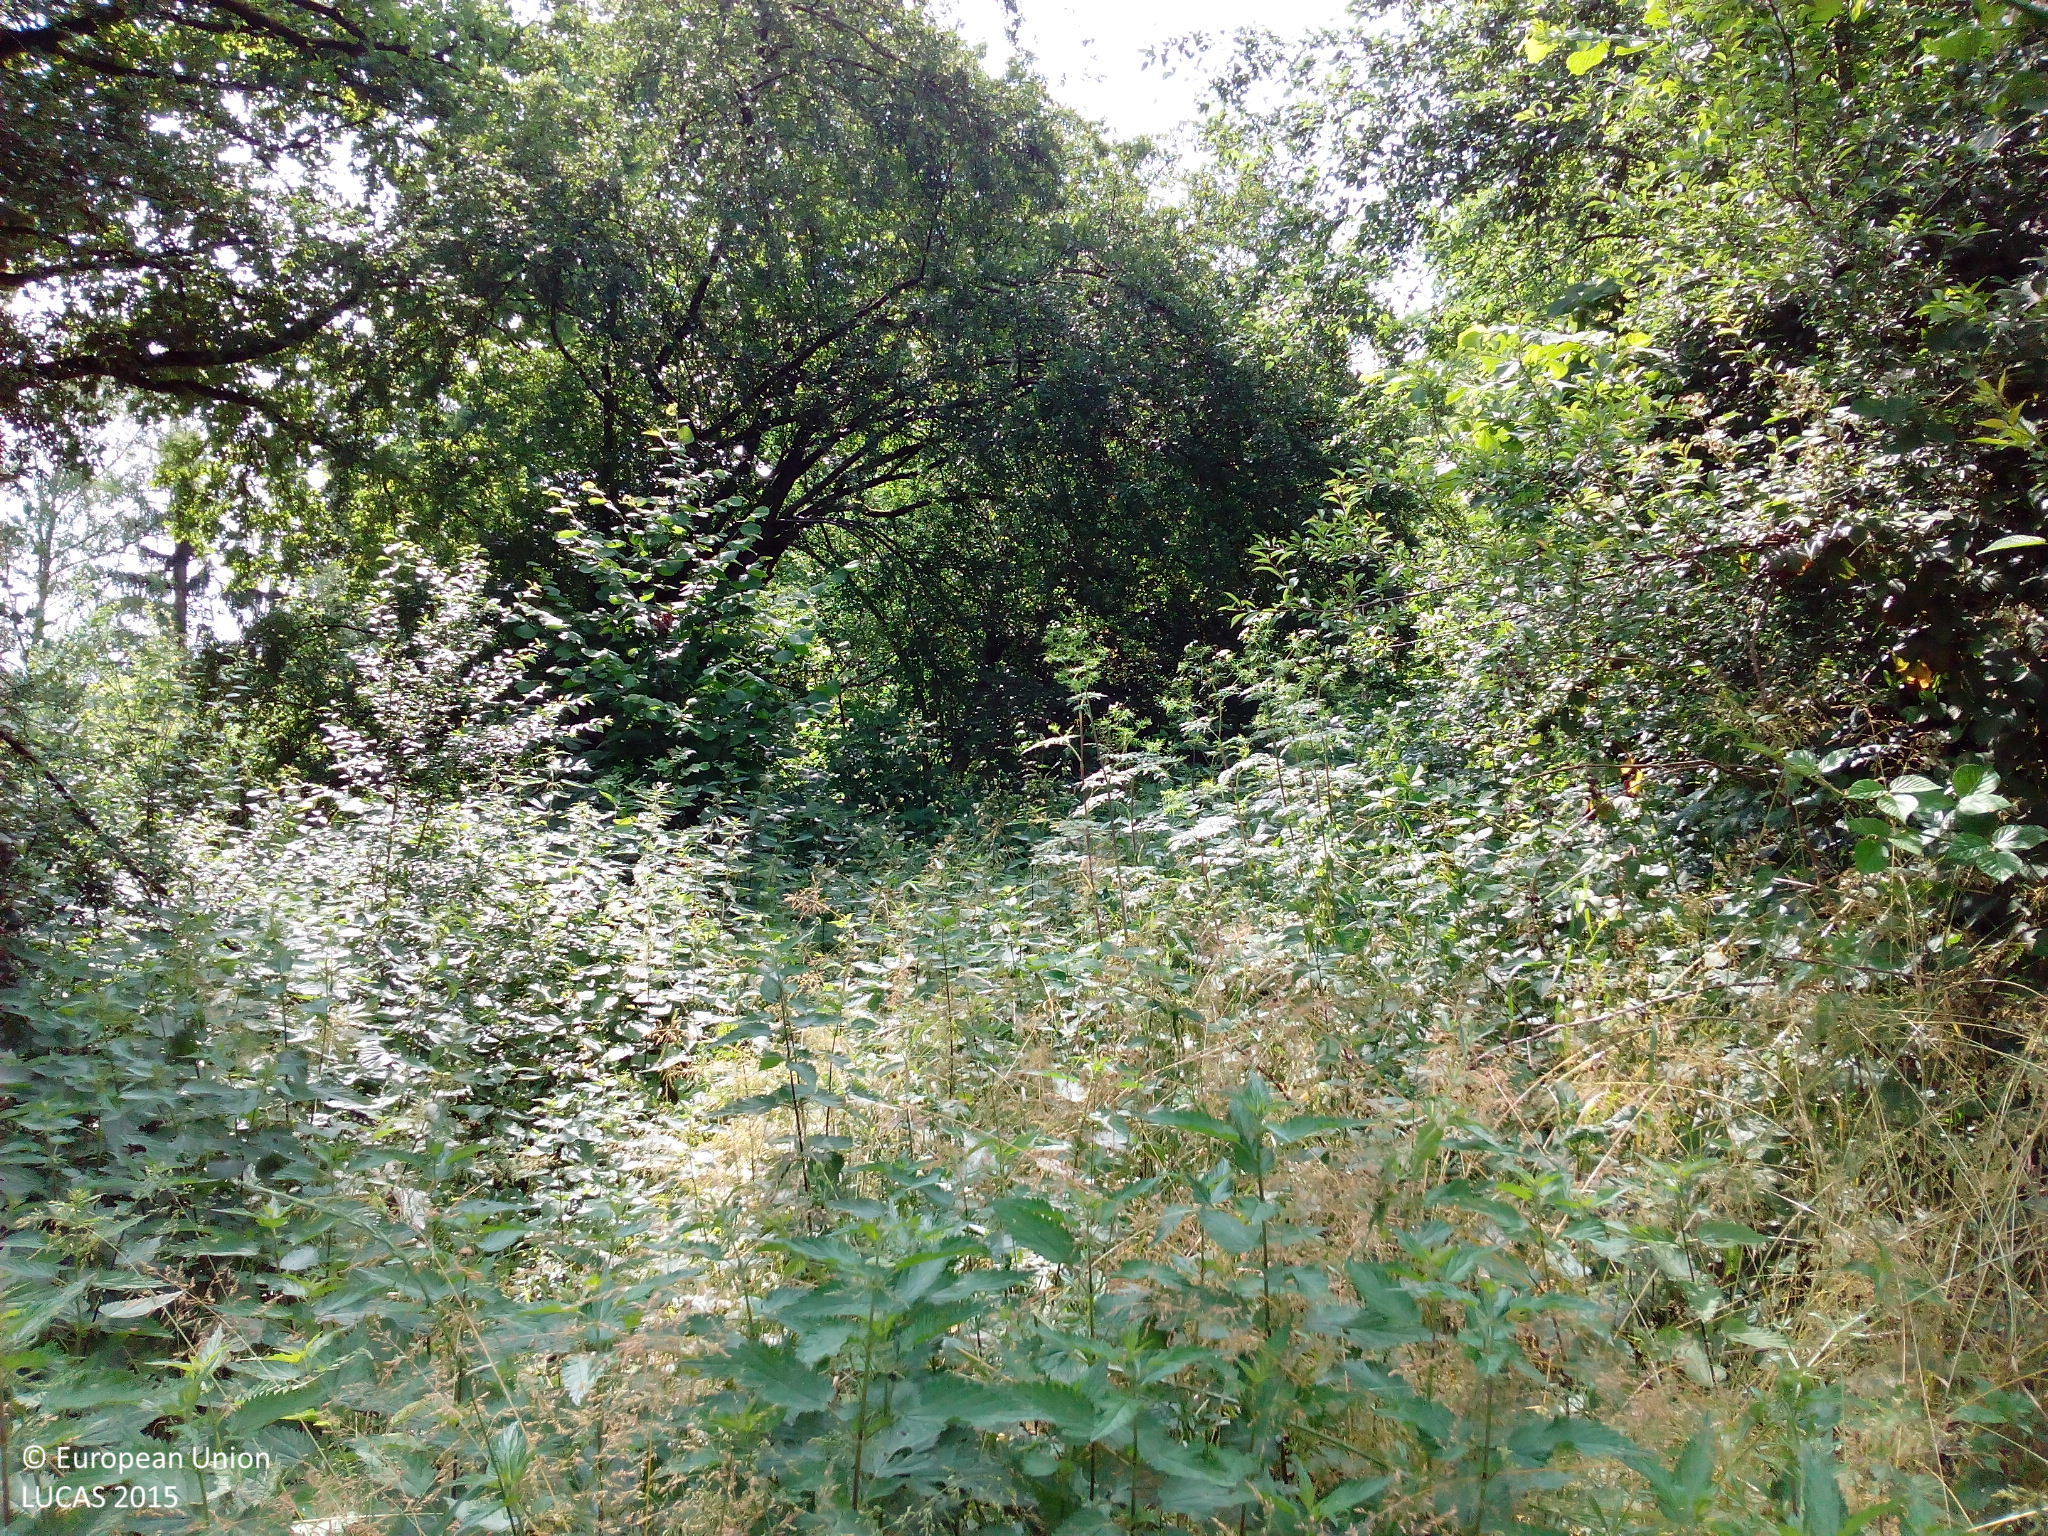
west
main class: Shrubland
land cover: Shrubland with sparse tree cover
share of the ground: > 75 %
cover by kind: herbaceous plants 50 %, shrubs 45 %, broadleaved forest trees 5 %
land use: Semi-natural and natural areas not in use
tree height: < 5 m
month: June
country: DE
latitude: 48.7070
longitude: 9.2801
